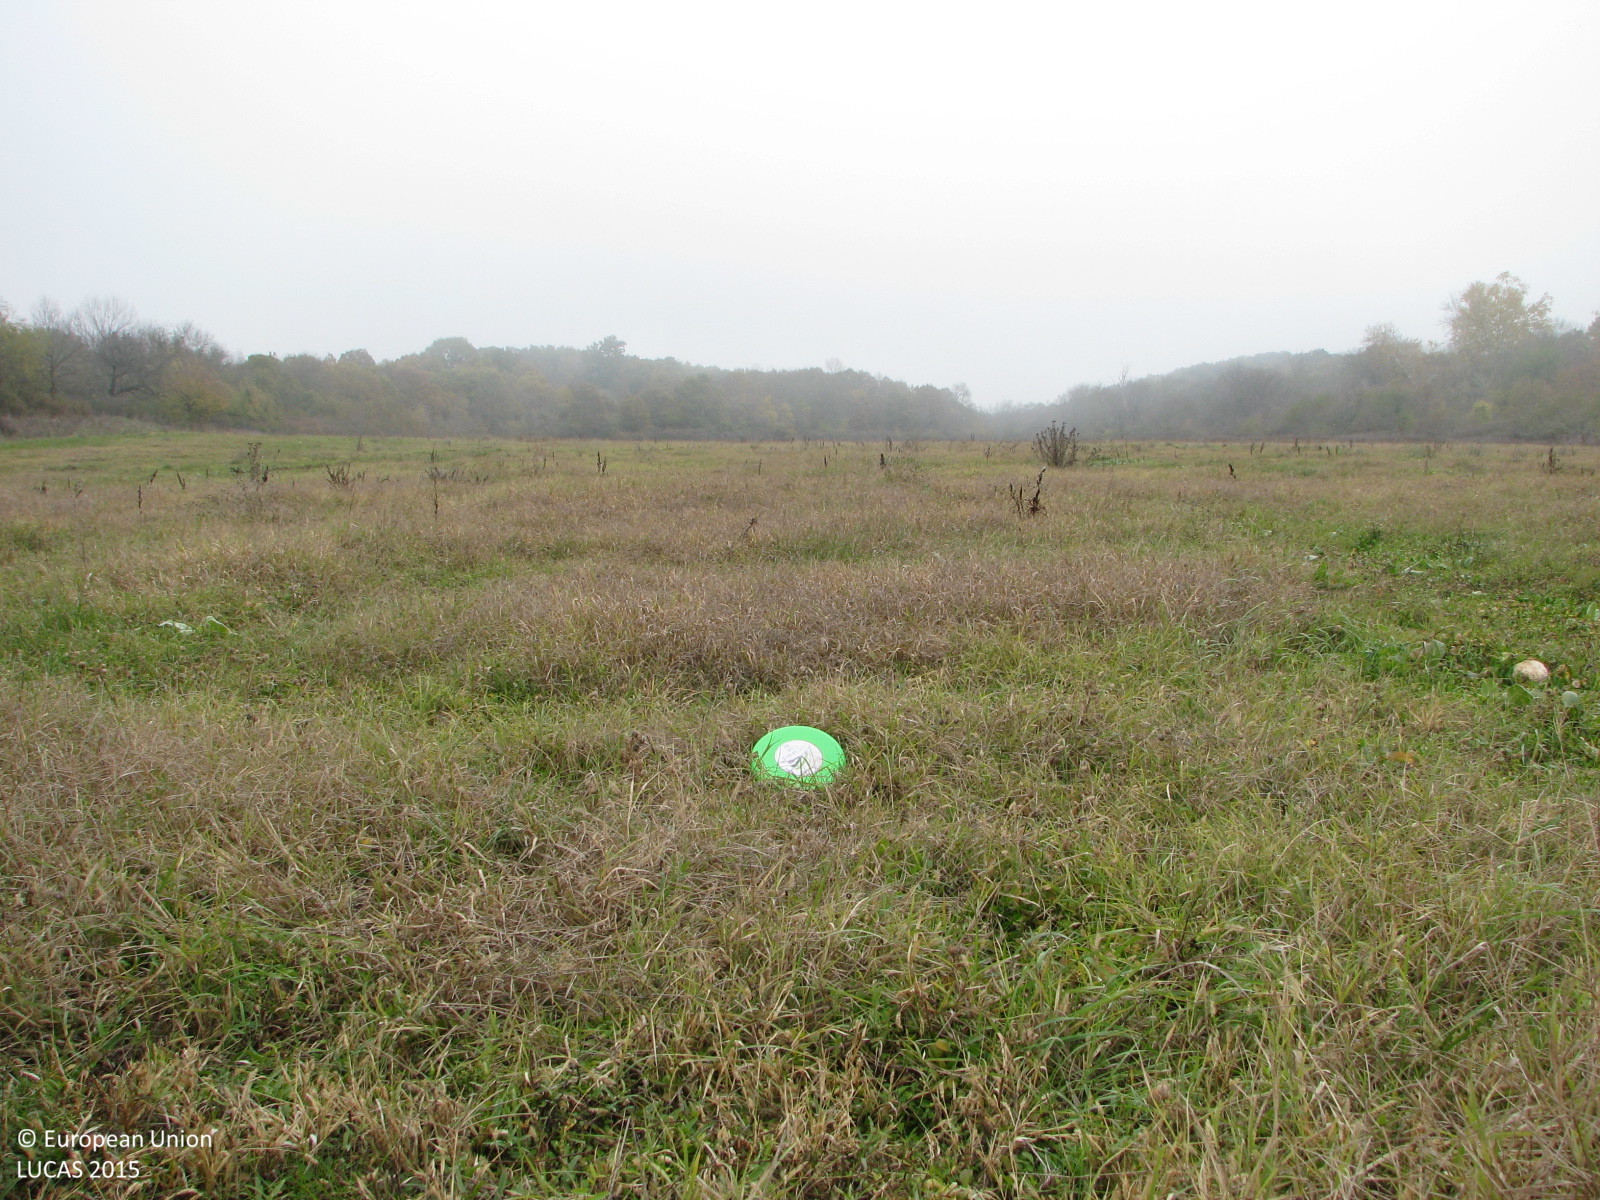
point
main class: Grassland
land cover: Grassland without tree/shrub cover
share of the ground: > 75 %
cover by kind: herbaceous plants 100 %
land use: Agriculture (excluding fallow land and kitchen gardens)
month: November
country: BG
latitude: 42.0859
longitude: 26.6897
